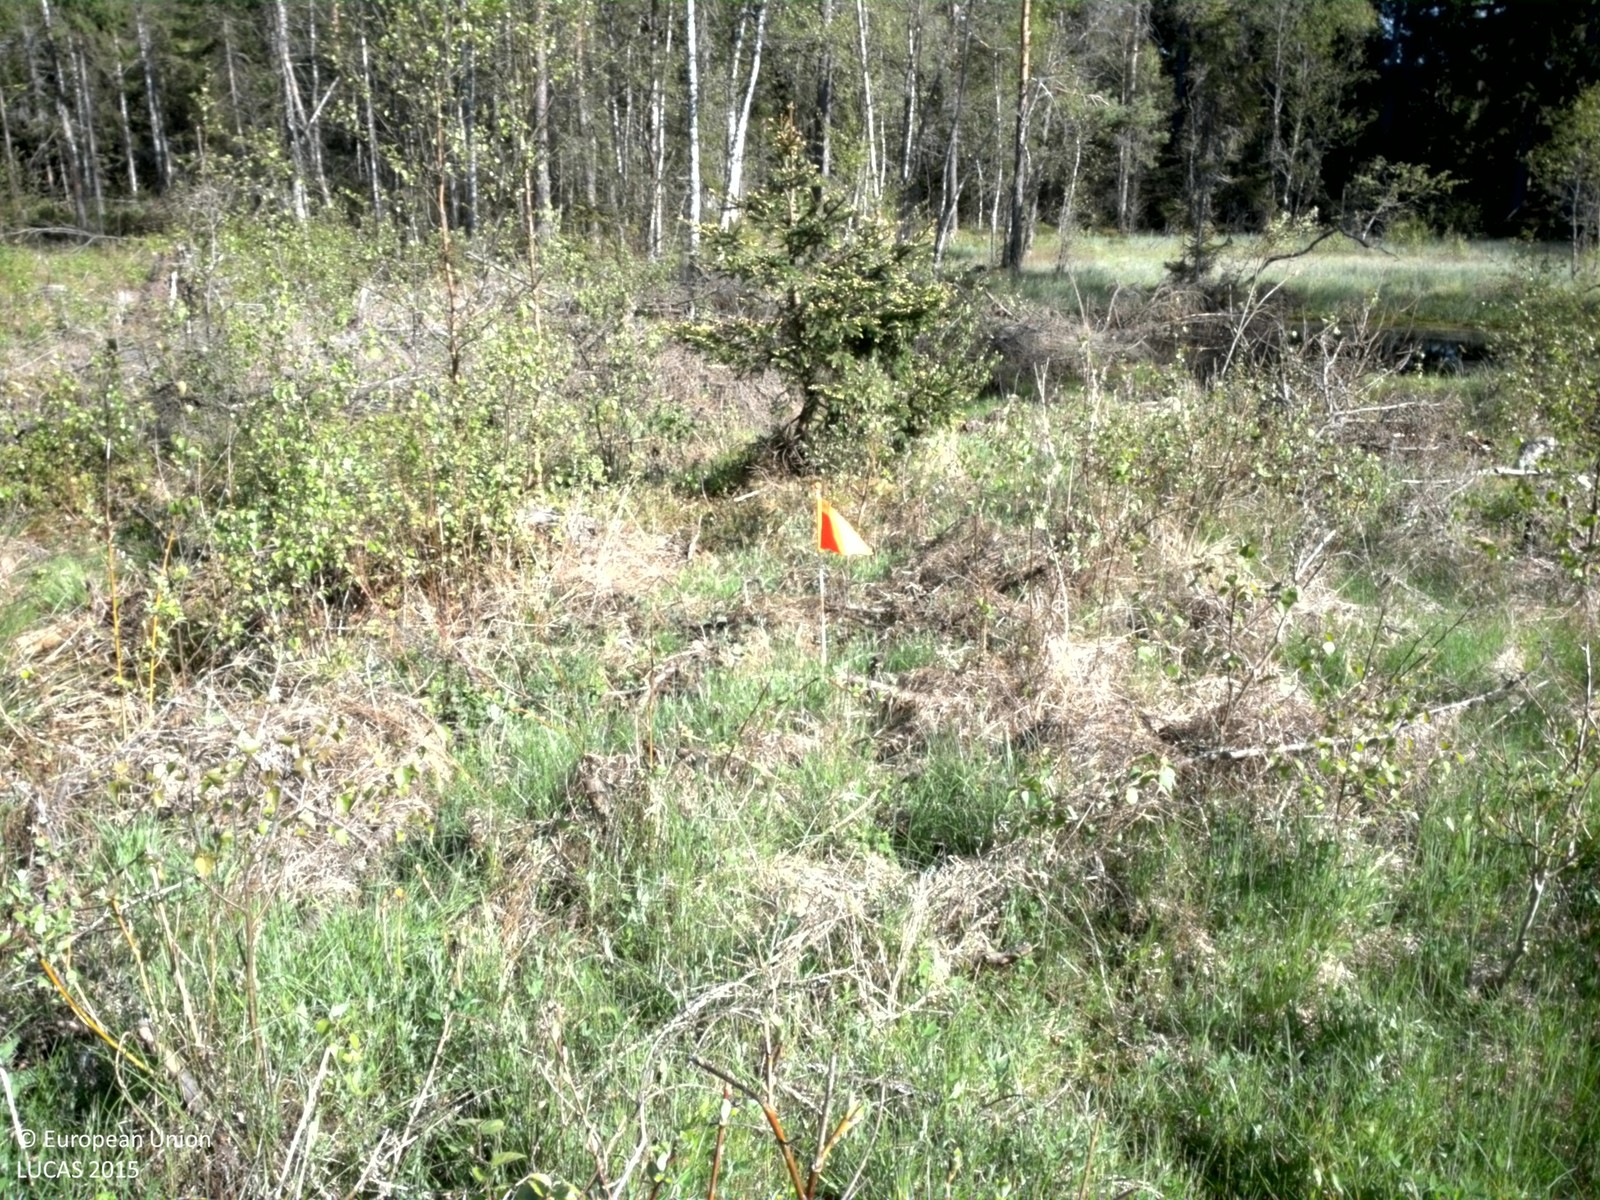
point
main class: Woodland
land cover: Broadleaved woodland
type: boreal forest
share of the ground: > 75 %
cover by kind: broadleaved forest trees 70 %, herbaceous plants 20 %, coniferous forest trees 5 %, shrubs 5 %
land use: Forestry
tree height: < 5 m
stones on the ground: < 10 %
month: May
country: SE
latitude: 56.5780
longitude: 15.4195
